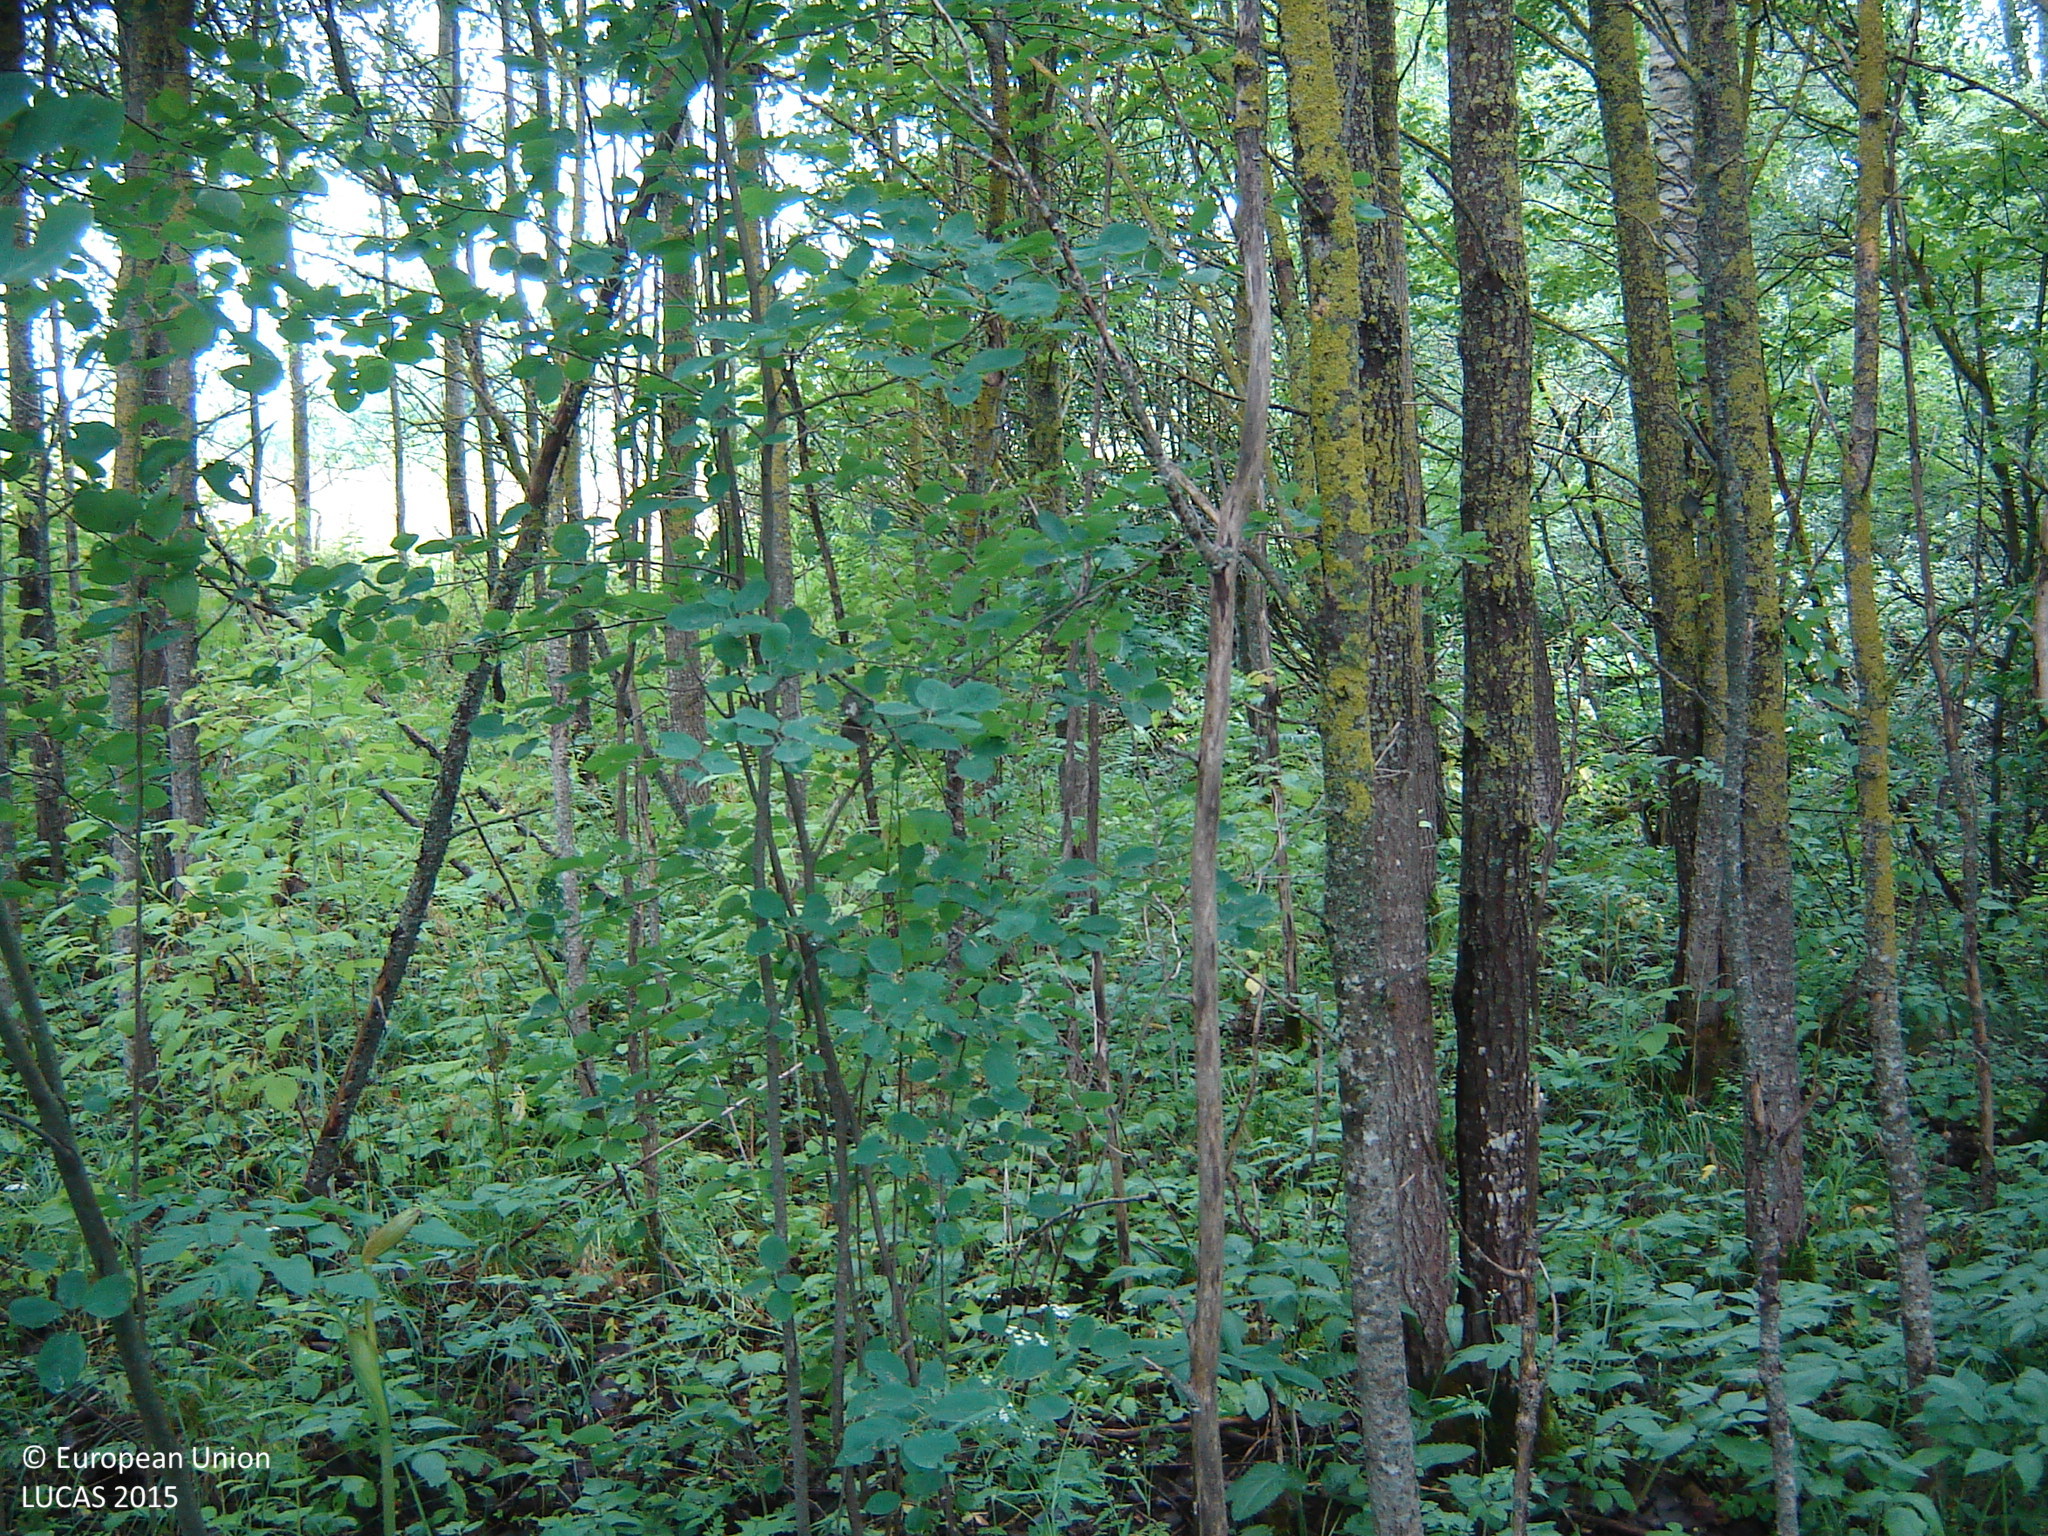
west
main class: Woodland
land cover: Broadleaved woodland
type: non-riverine alder, birch or aspen forest
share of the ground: > 75 %
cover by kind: broadleaved forest trees 90 %, herbaceous plants 10 %
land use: Forestry
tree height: > 5 m
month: July
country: LT
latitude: 55.3330
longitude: 25.1712
